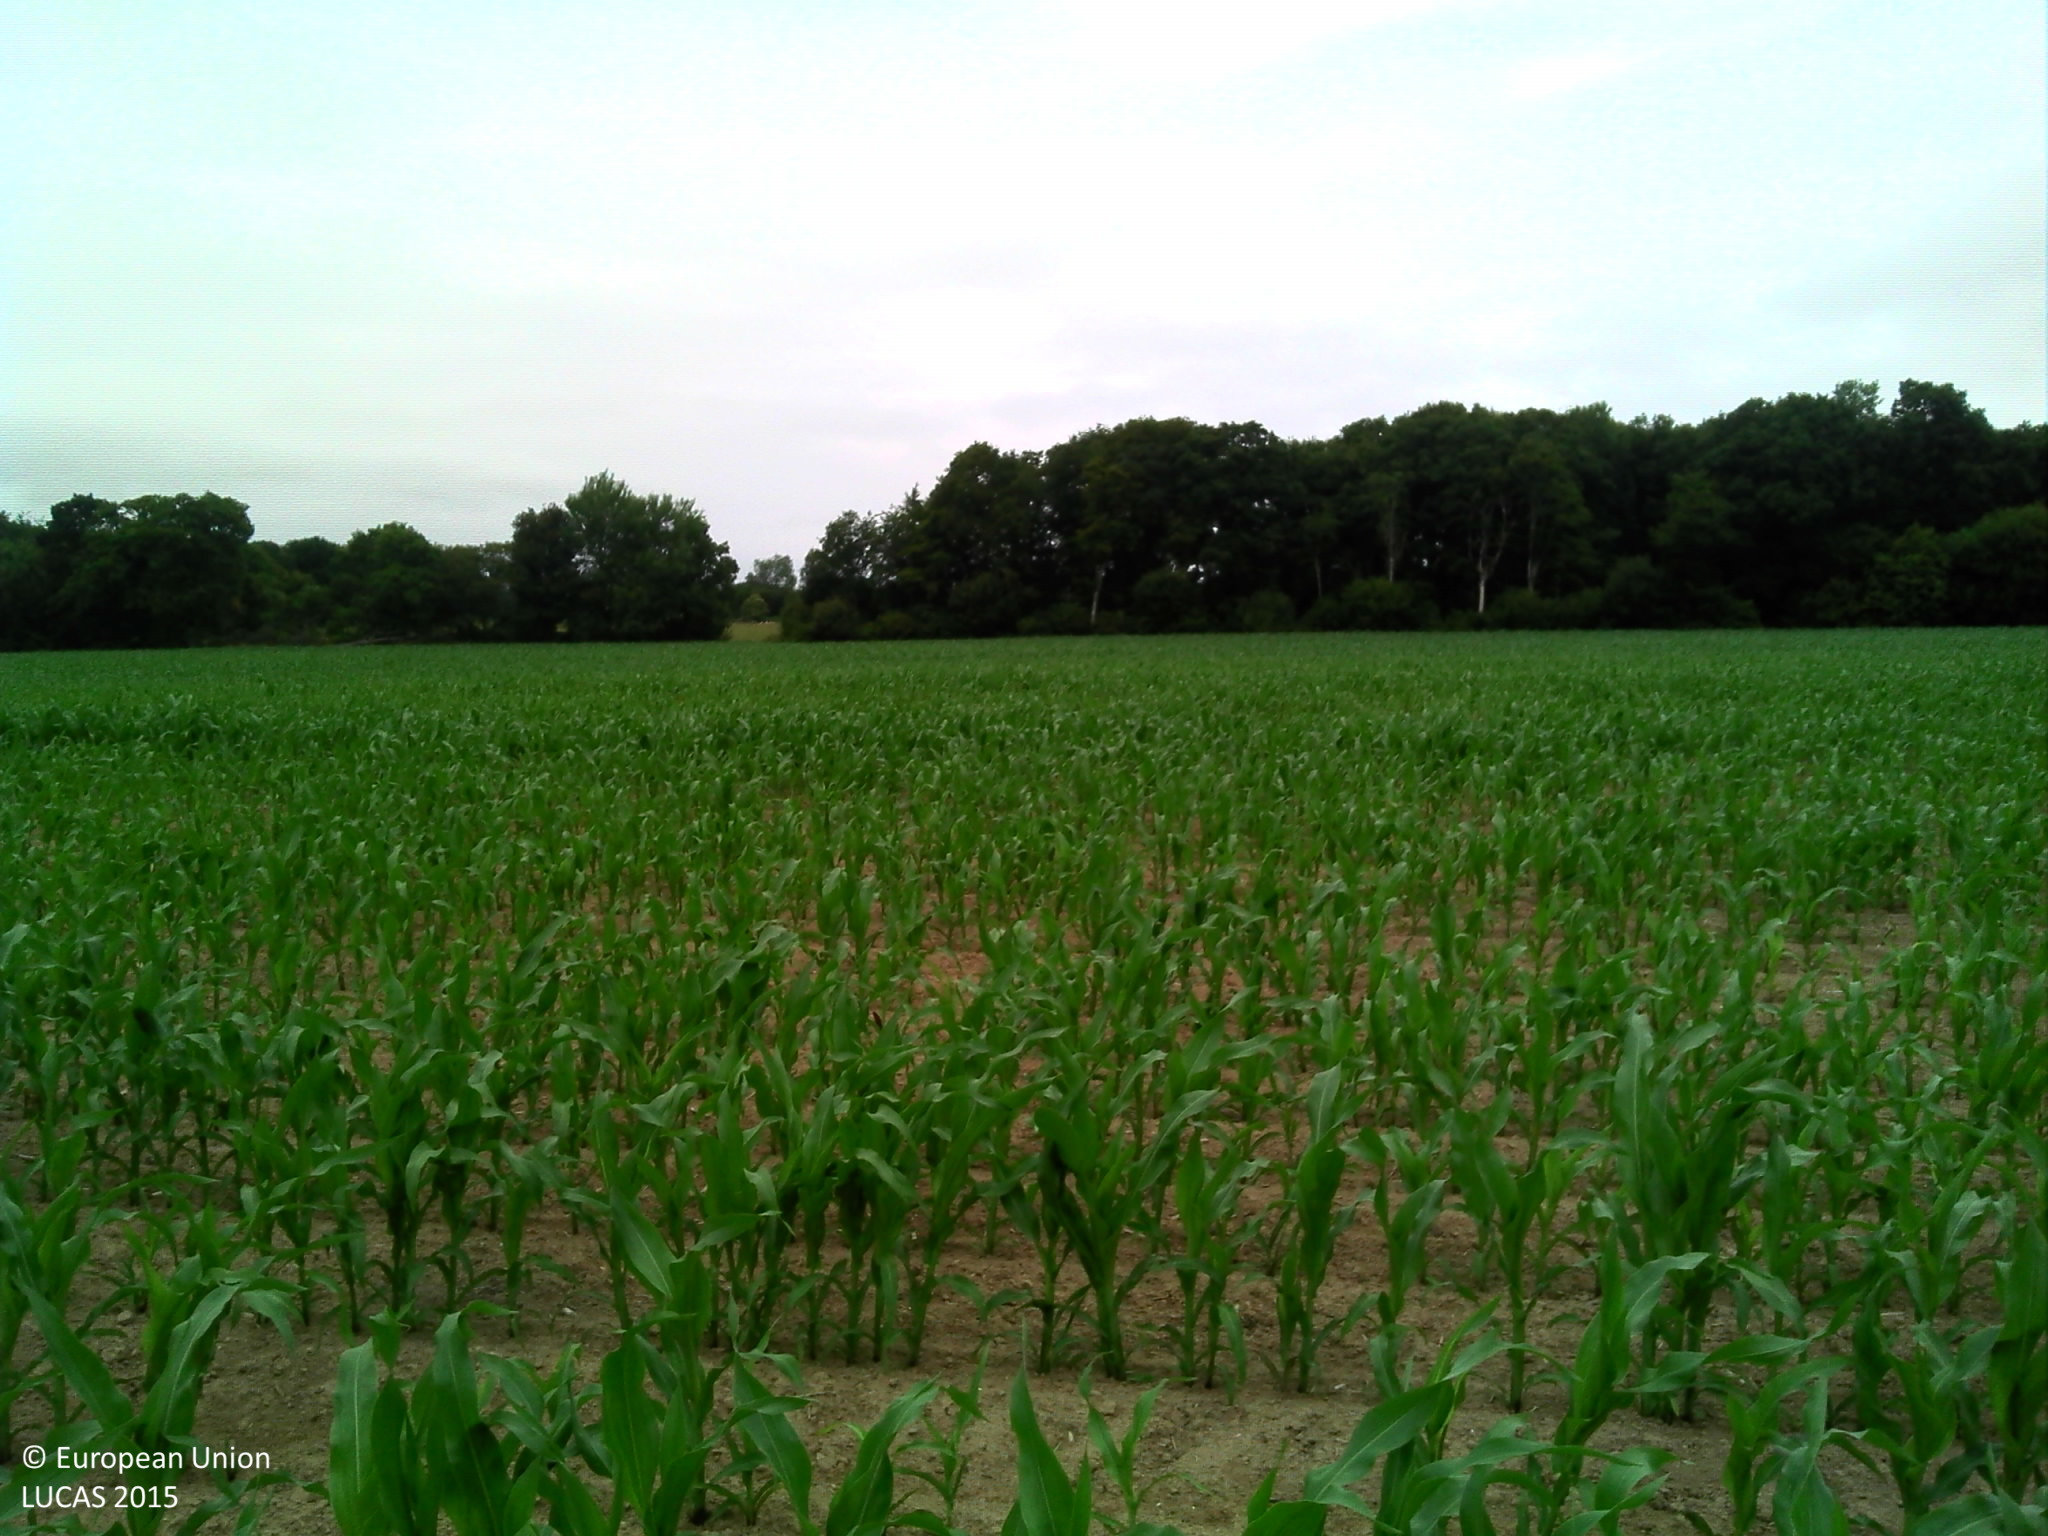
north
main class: Cropland
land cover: Maize
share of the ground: 50 - 75 %
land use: Agriculture (excluding fallow land and kitchen gardens)
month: July
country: FR
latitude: 48.6610
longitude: -3.5348
